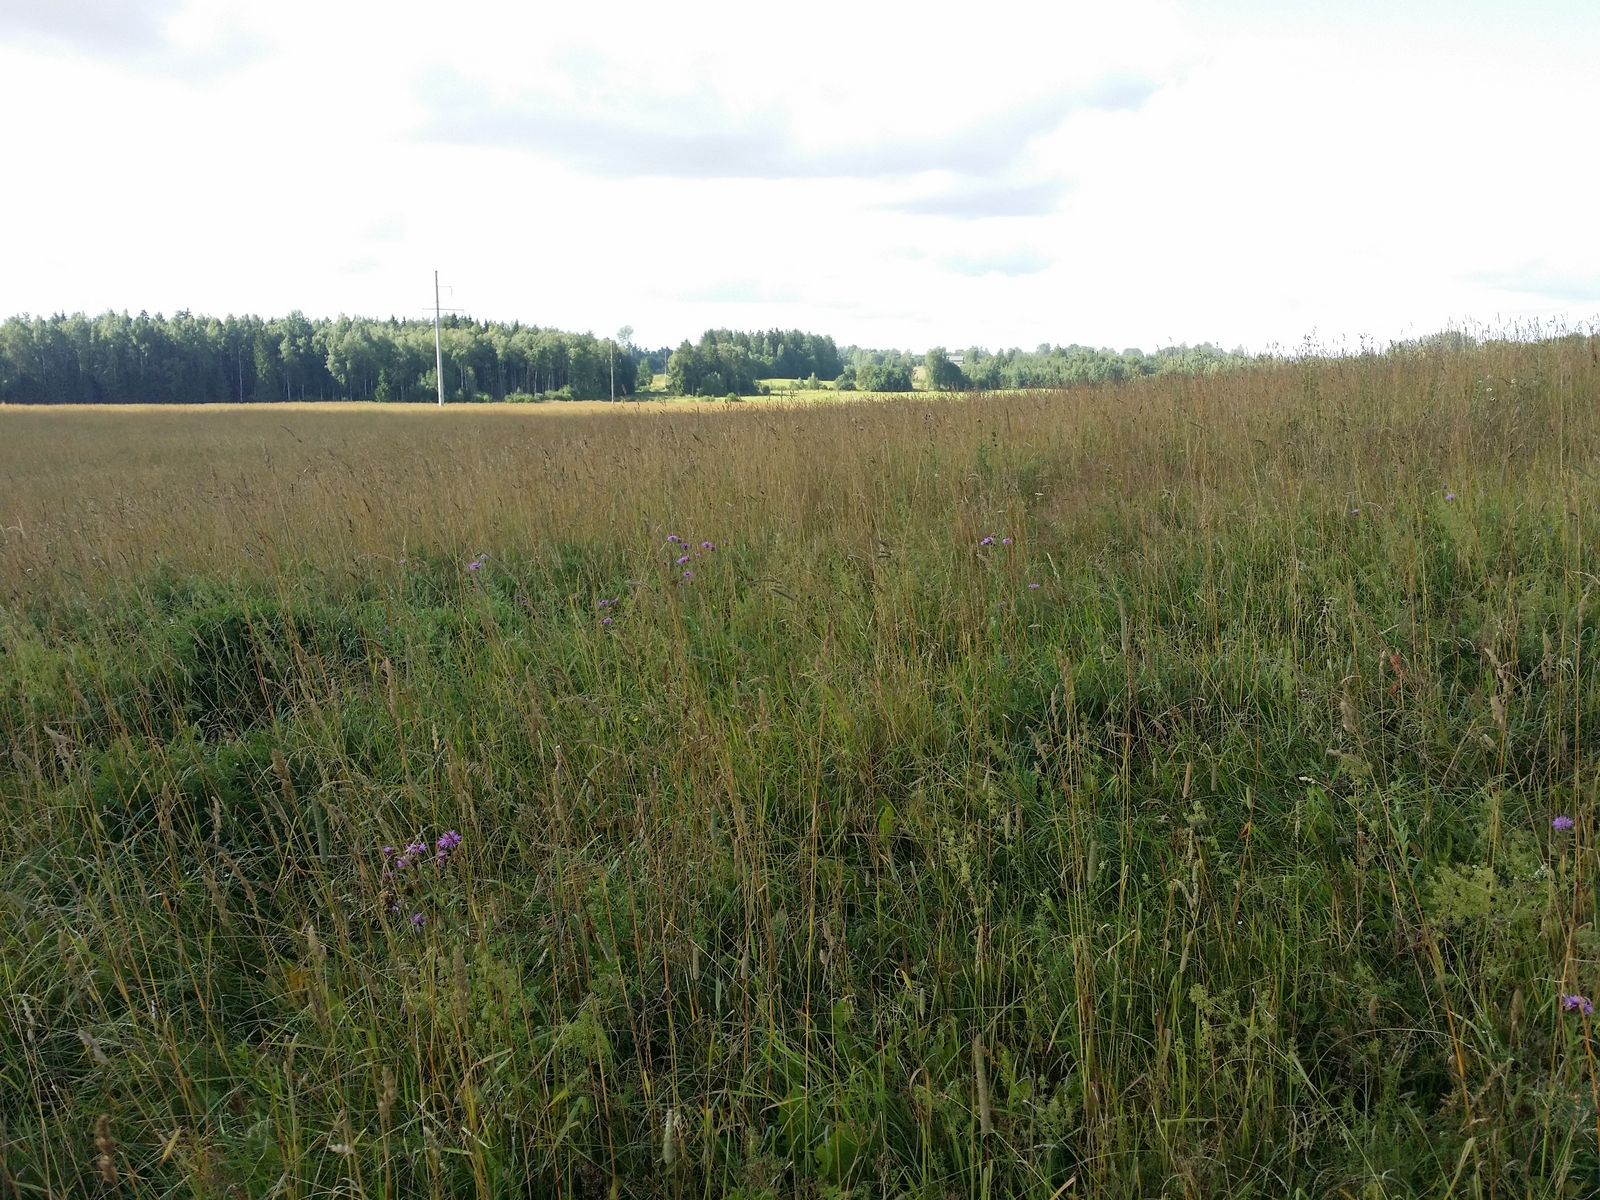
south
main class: Grassland
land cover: Grassland without tree/shrub cover
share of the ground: > 75 %
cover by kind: herbaceous plants 100 %
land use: Agriculture (excluding fallow land and kitchen gardens)
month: July
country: LV
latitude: 57.2281
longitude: 26.7660
